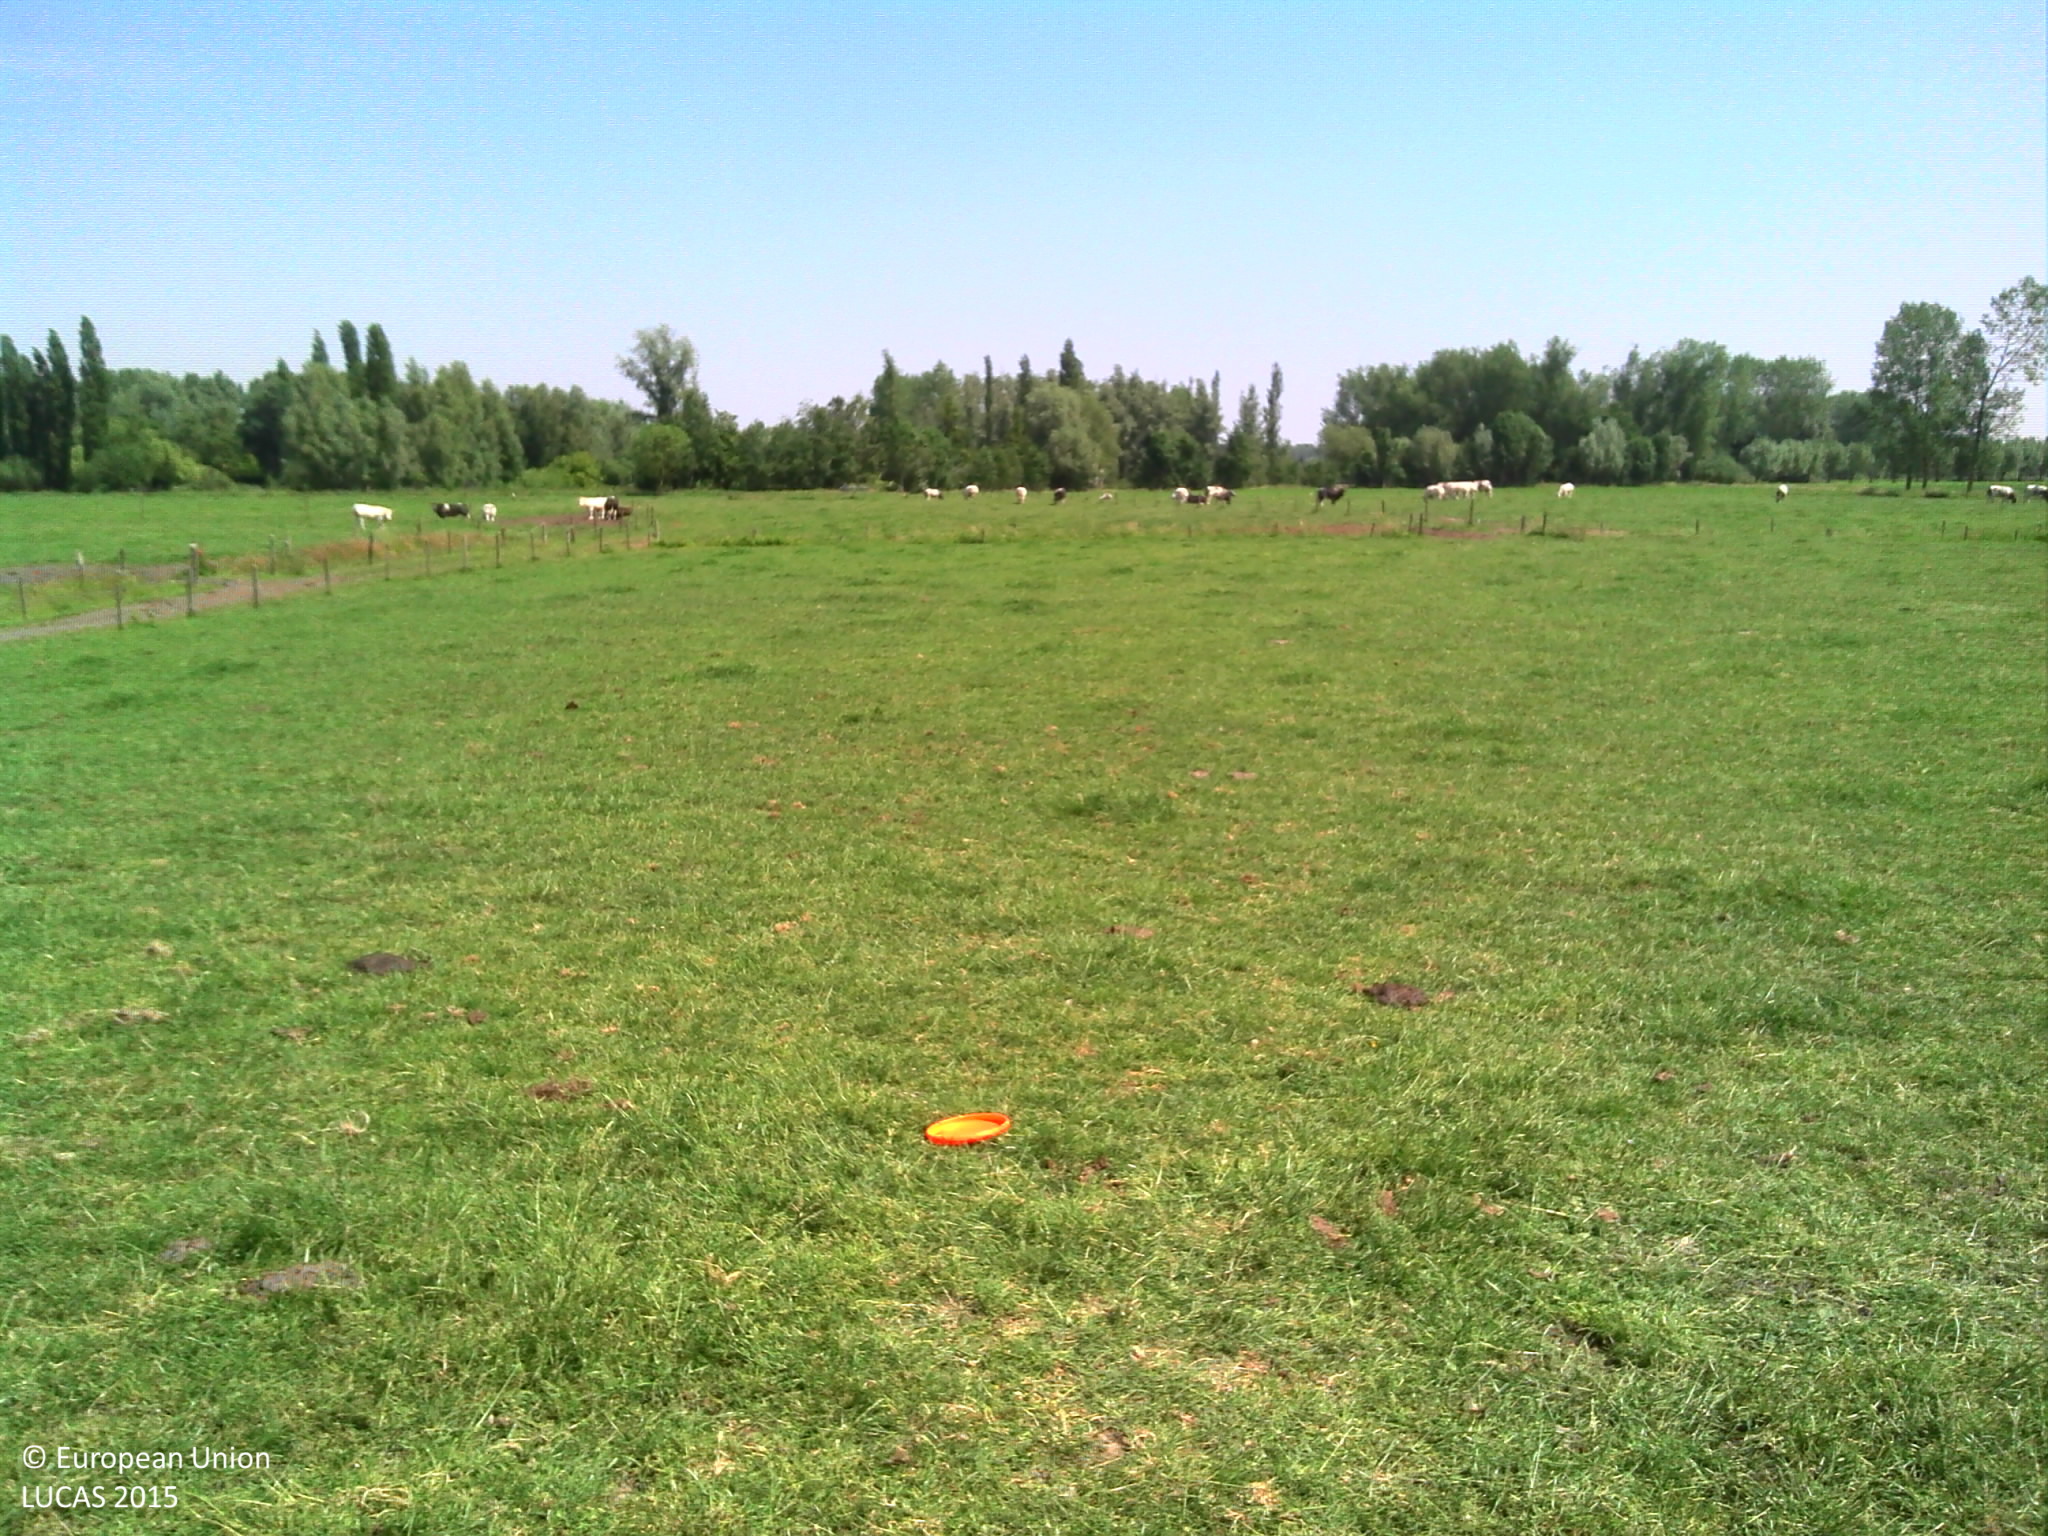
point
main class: Grassland
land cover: Grassland without tree/shrub cover
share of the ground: > 75 %
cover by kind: herbaceous plants 100 %
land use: Agriculture (excluding fallow land and kitchen gardens)
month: June
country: BE
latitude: 51.0950
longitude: 4.0972
